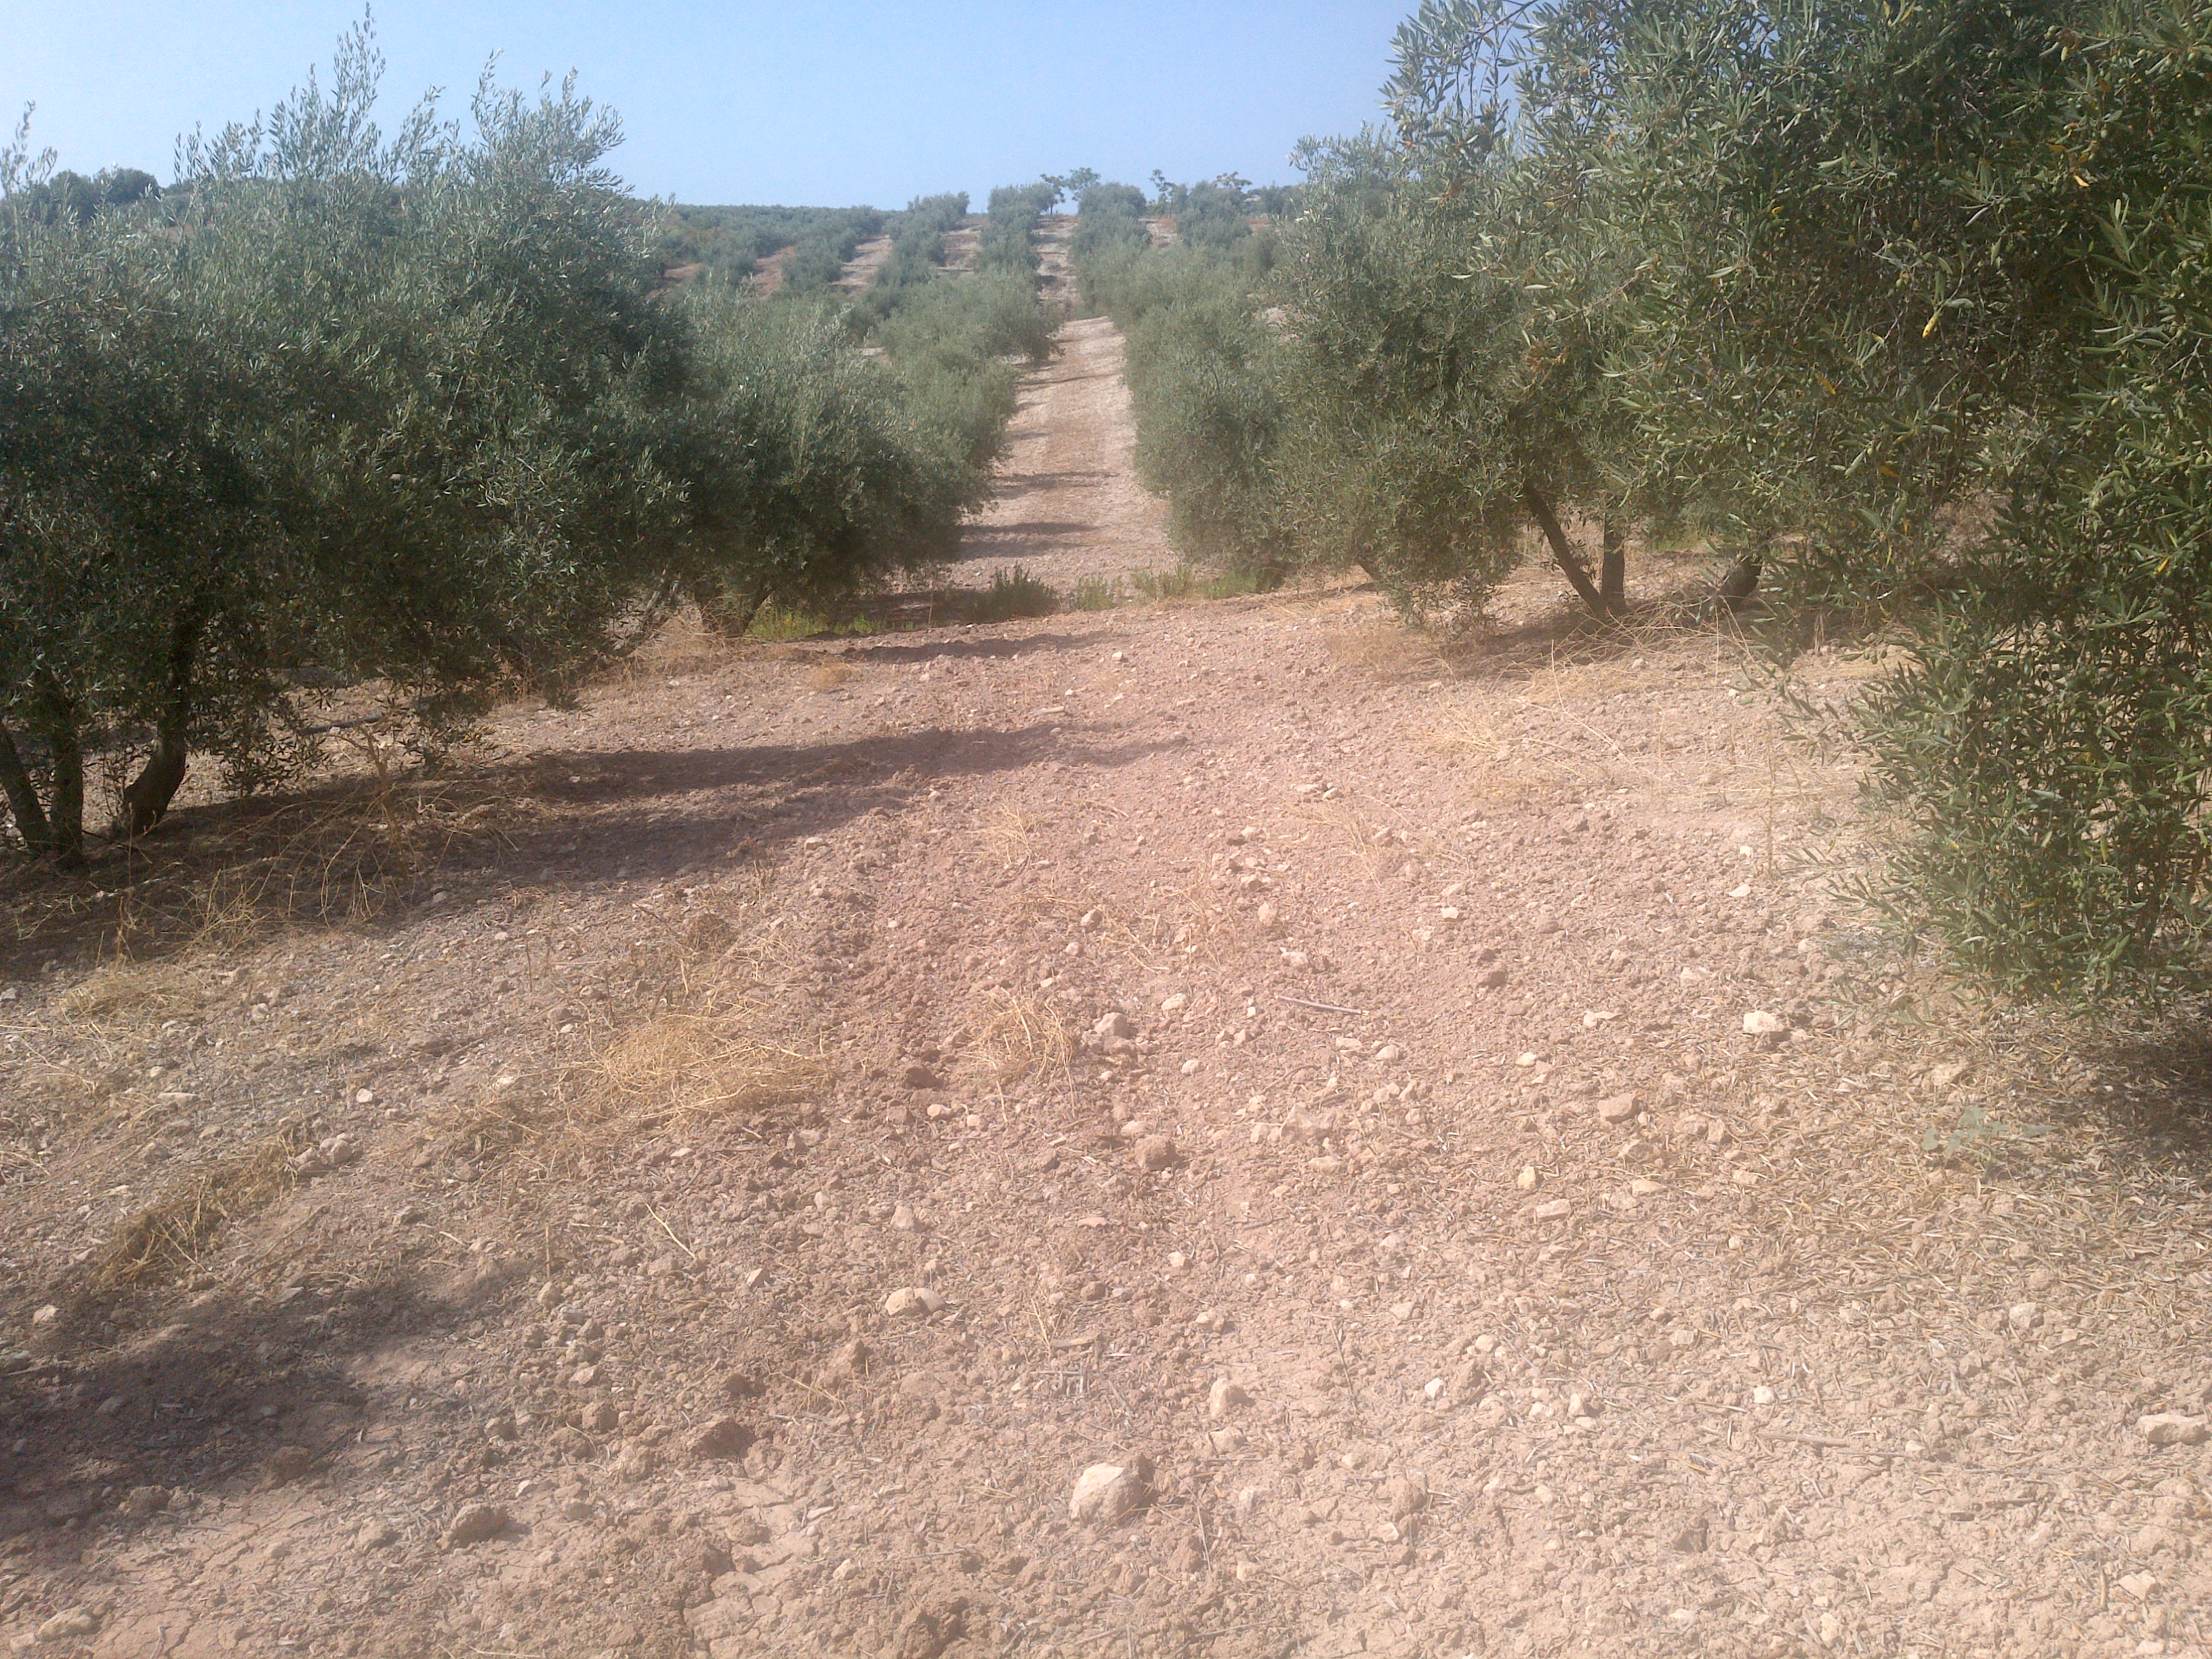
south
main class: Cropland
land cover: Olive groves
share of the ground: 50 - 75 %
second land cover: Other bare soil
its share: > 75 %
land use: Agriculture (excluding fallow land and kitchen gardens)
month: June
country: ES
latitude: 37.6782
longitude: -4.2569
